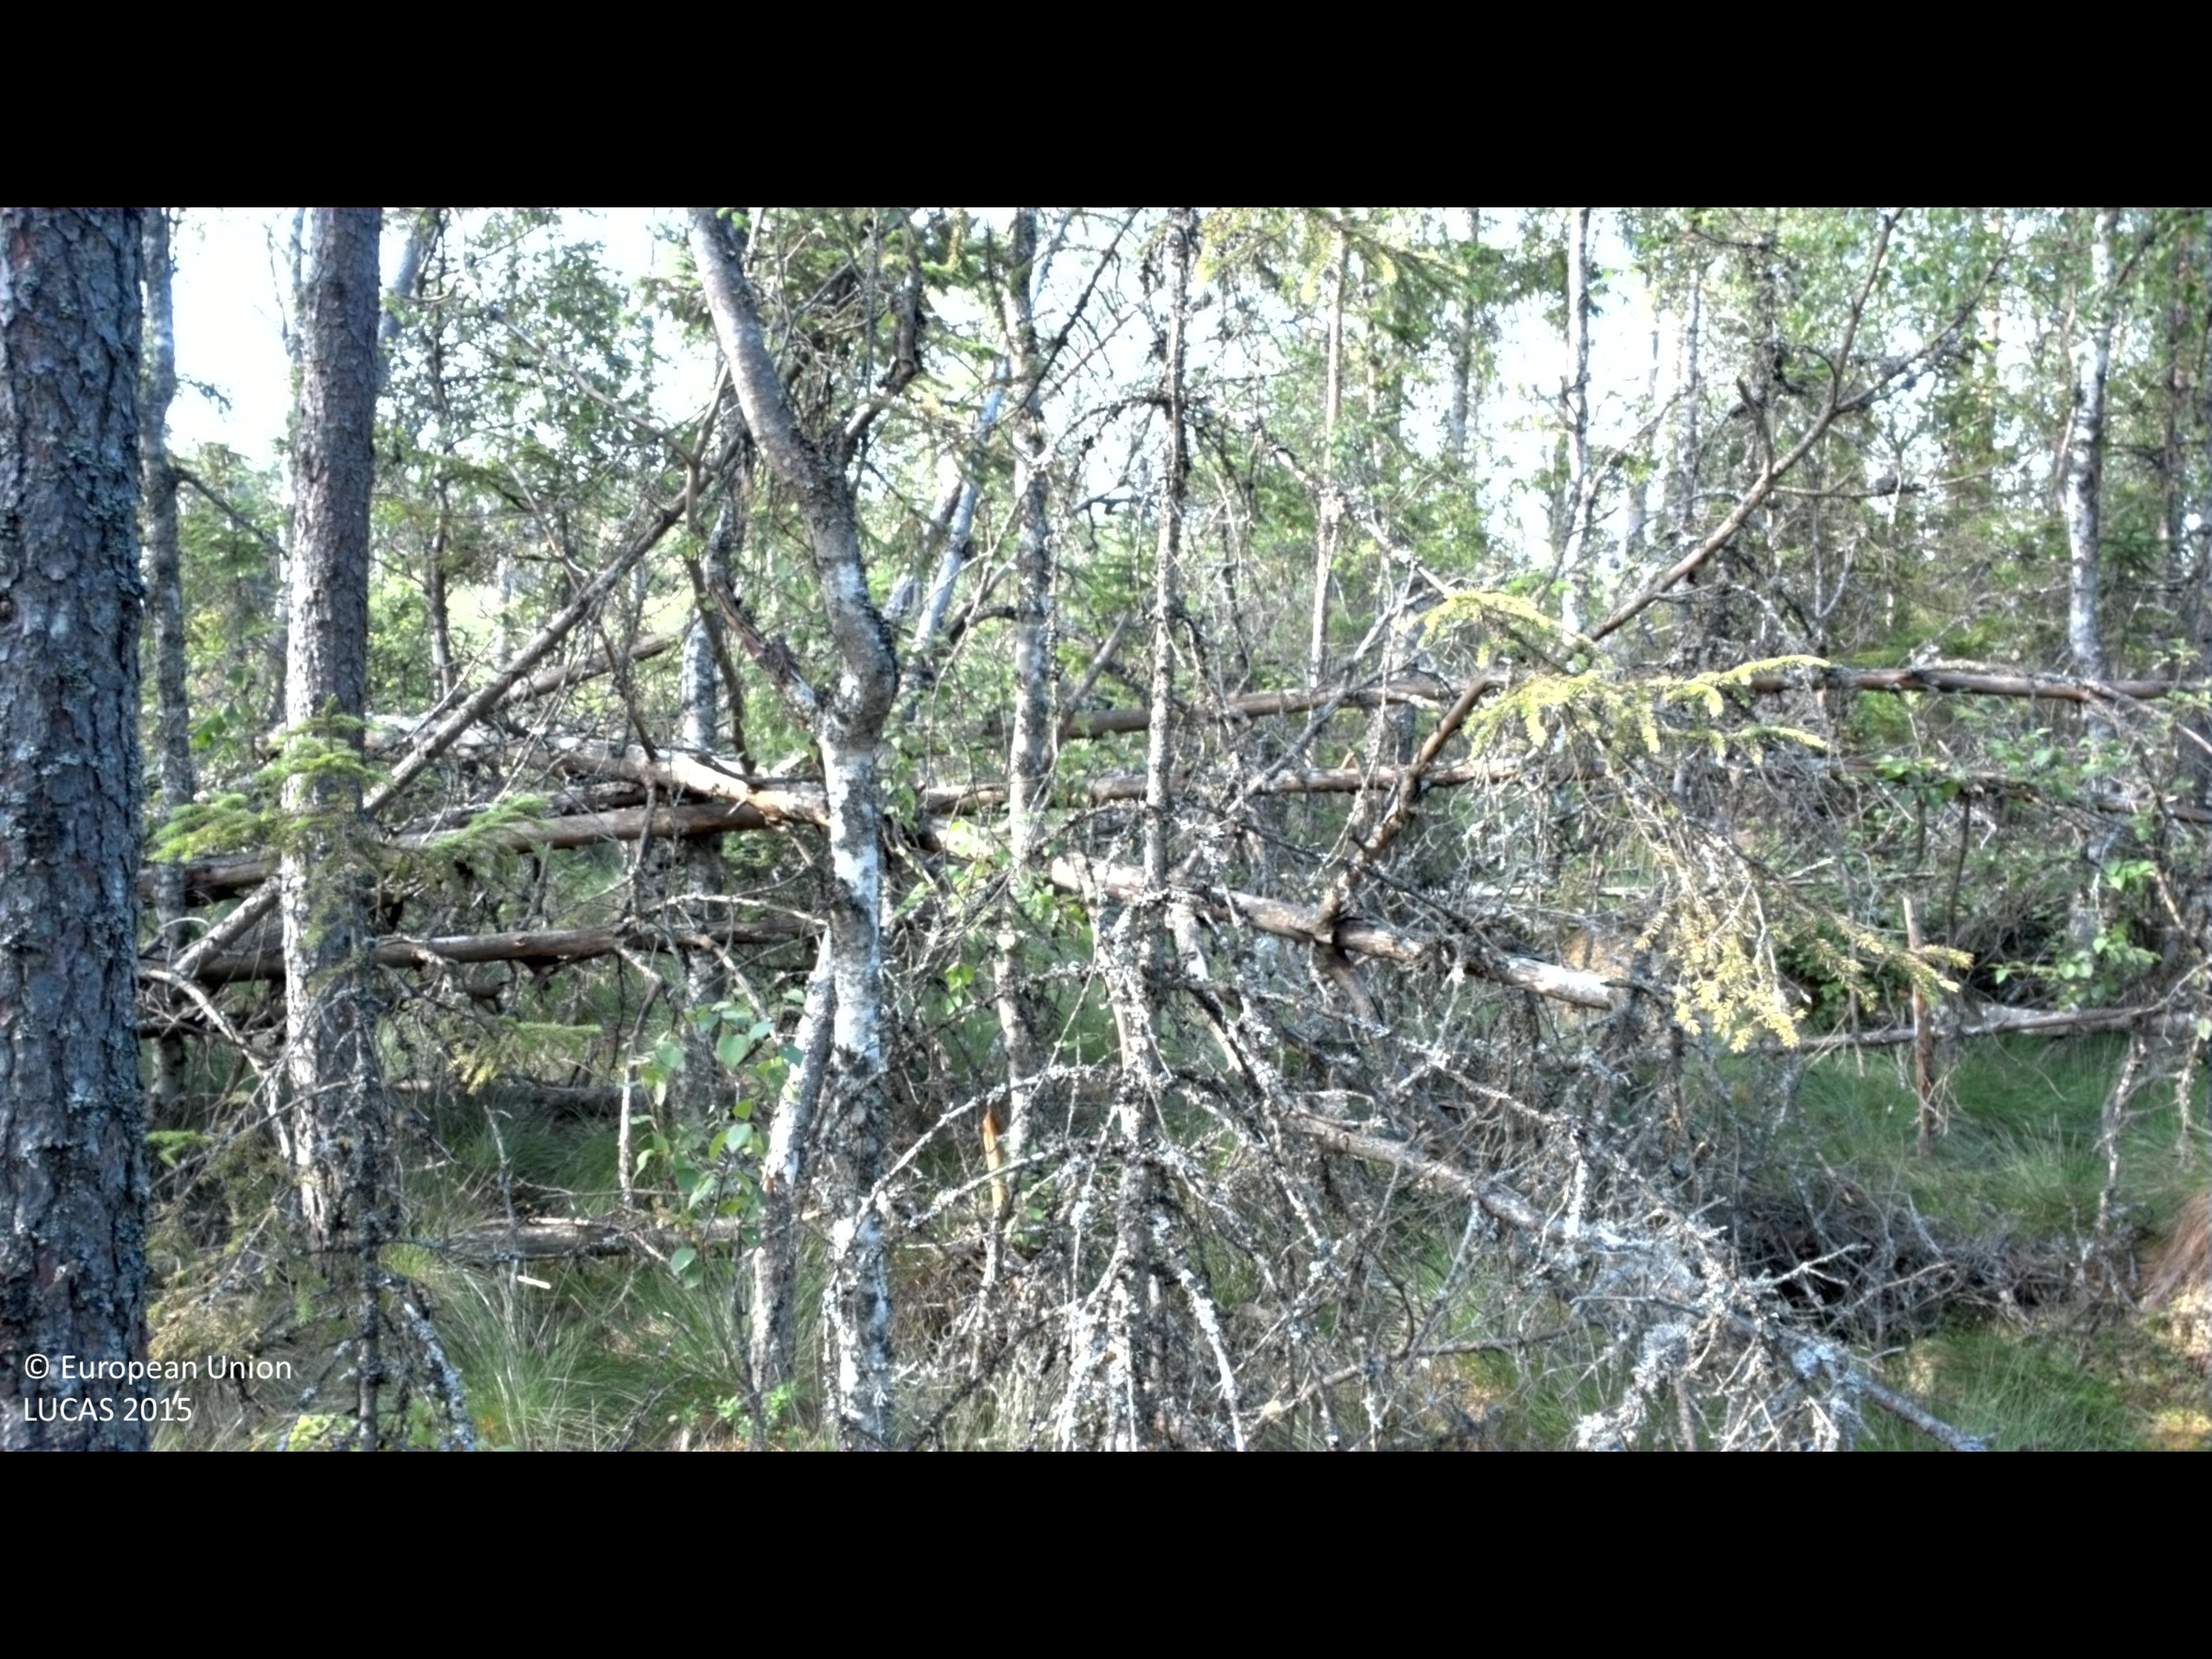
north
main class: Woodland
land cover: Pine dominated mixed woodland
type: mire and swamp forests
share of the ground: 50 - 75 %
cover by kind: broadleaved forest trees 35 %, herbaceous plants 35 %, coniferous forest trees 30 %
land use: Semi-natural and natural areas not in use
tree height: > 5 m
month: August
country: SE
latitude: 56.7355
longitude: 14.0671
